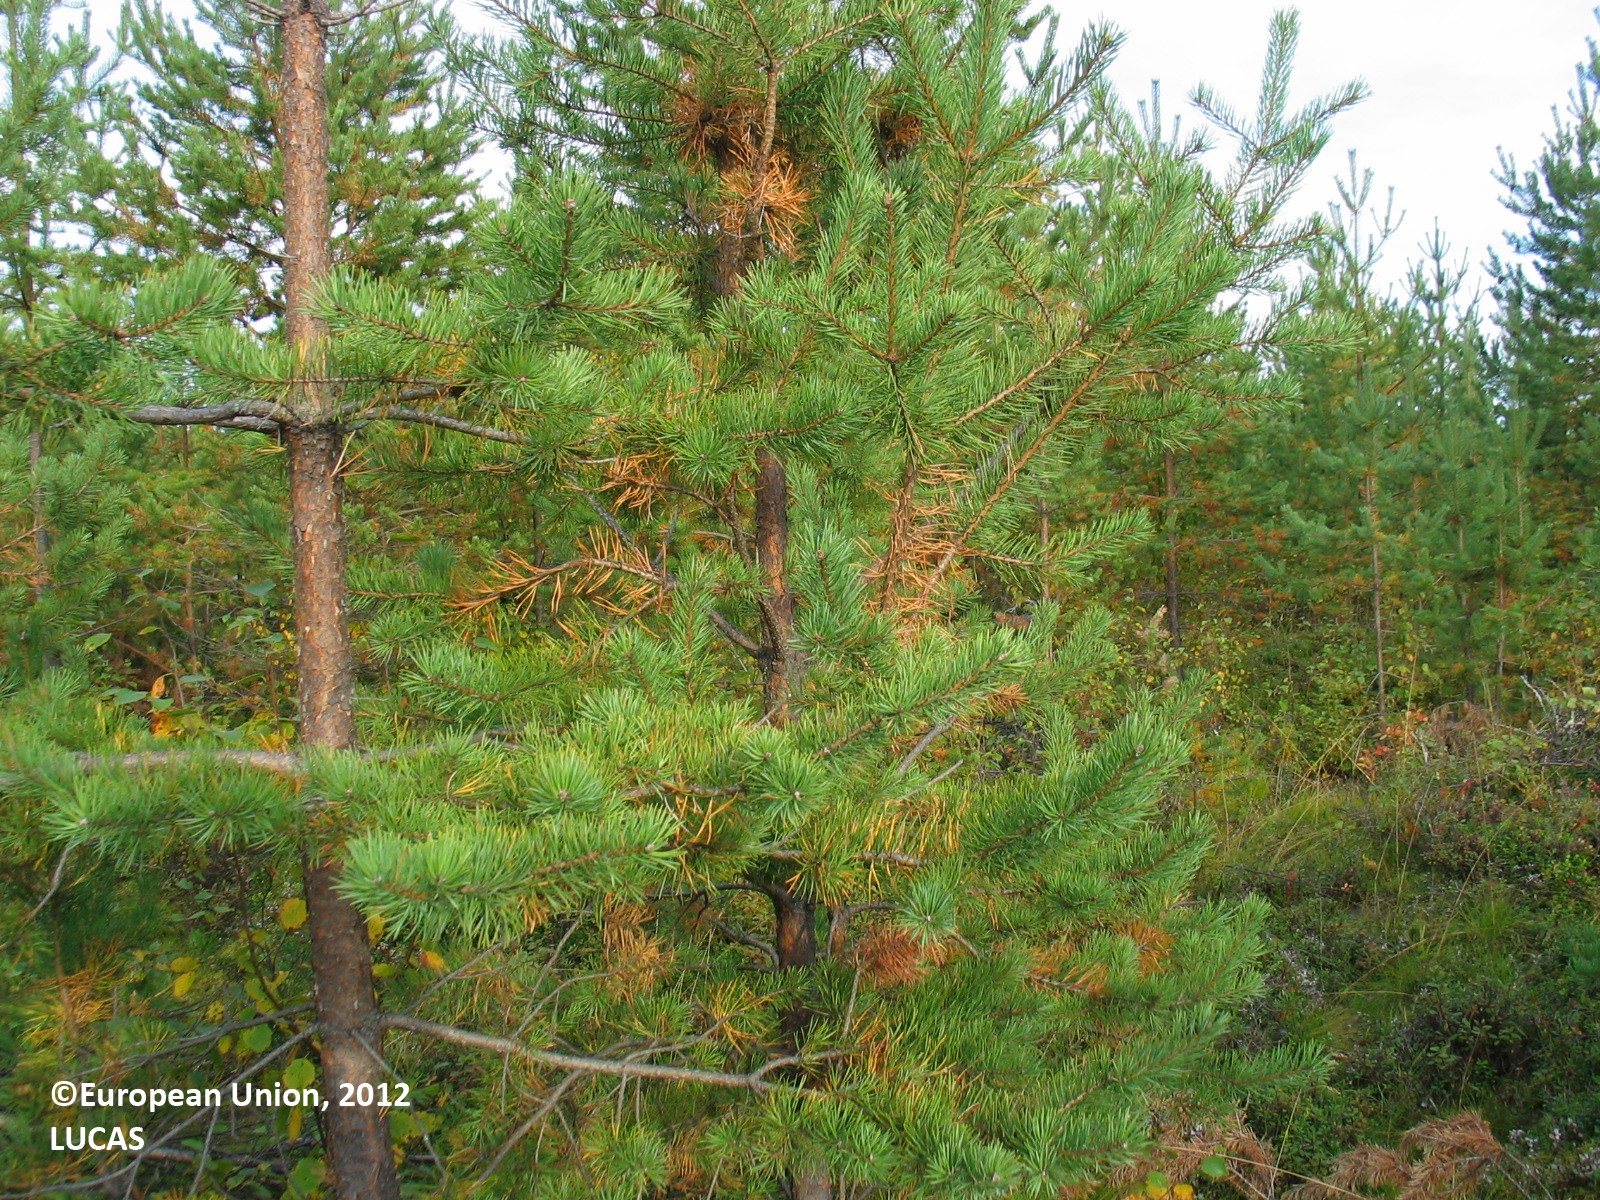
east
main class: Woodland
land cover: Pine dominated coniferous woodland
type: boreal forest
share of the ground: 50 - 75 %
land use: Forestry
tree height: < 5 m
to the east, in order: Pine dominated coniferous woodland; Ditches and canals; Pine dominated coniferous woodland; Ditches and canals; Pine dominated coniferous woodland; Ditches and canals; Pine dominated coniferous woodland; Ditches and canals; Pine dominated coniferous woodland; Ditches and canals; Pine dominated coniferous woodland; Ditches and canals; Pine dominated coniferous woodland; Ditches and canals; Pine dominated coniferous woodland; Ditches and canals; Pine dominated coniferous woodland; Ditches and canals; Pine dominated coniferous woodland; Ditches and canals; Pine dominated coniferous woodland; Ditches and canals; Pine dominated coniferous woodland; Ditches and canals; Pine dominated coniferous woodland
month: September
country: FI
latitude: 65.2517
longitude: 25.5601
